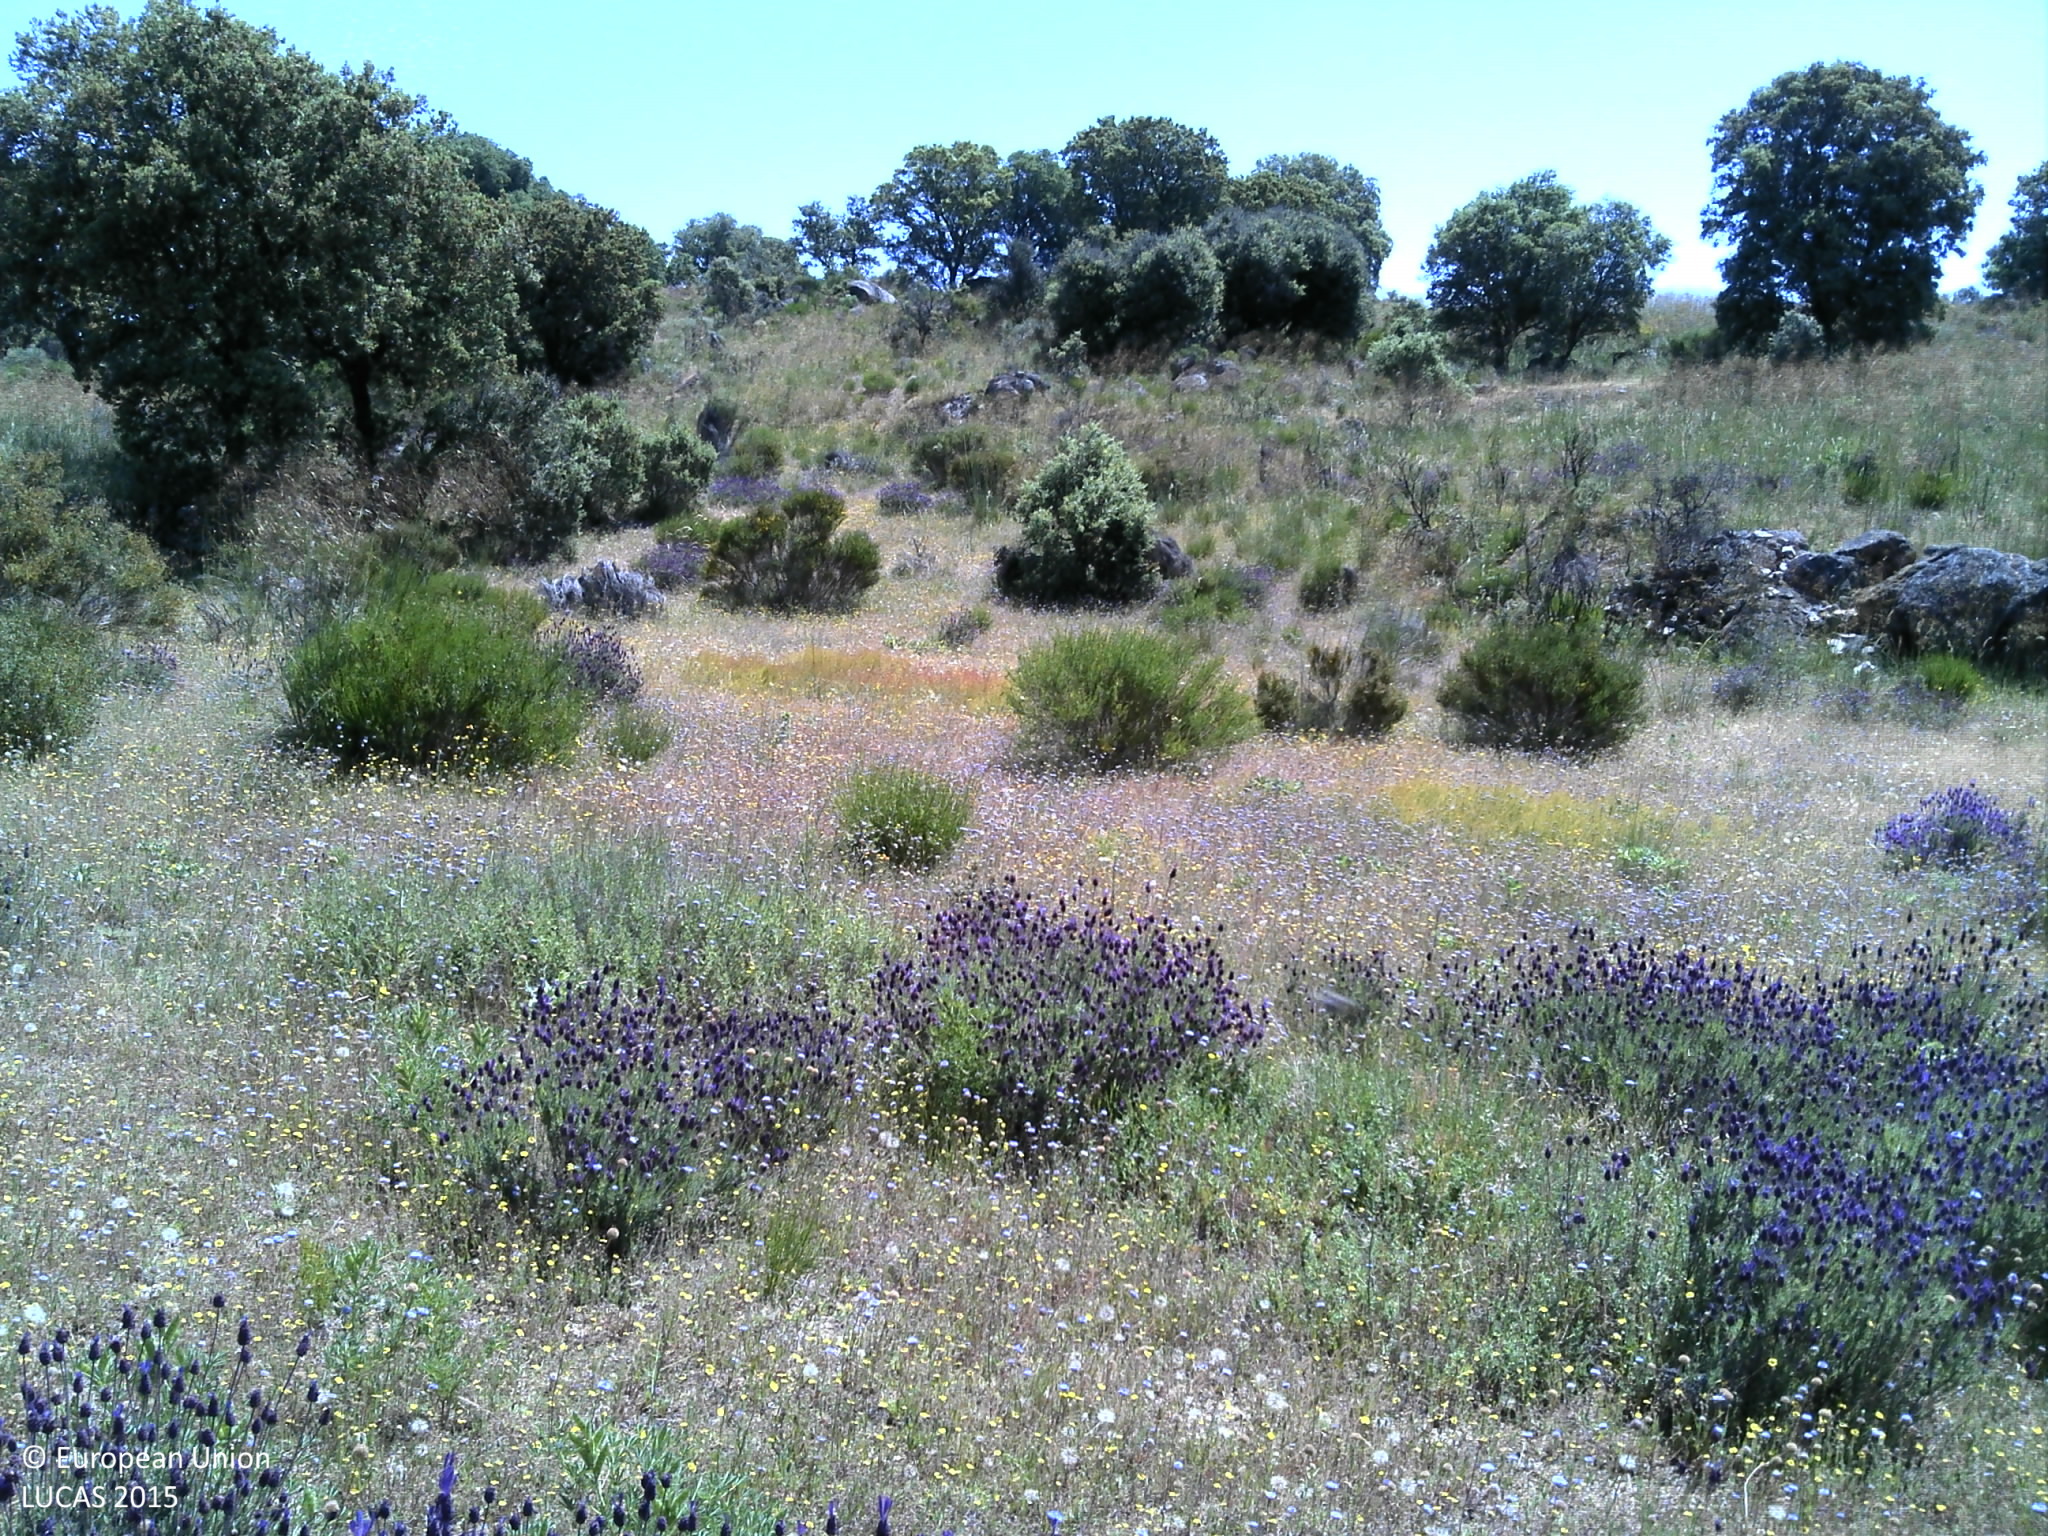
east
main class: Grassland
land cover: Grassland with sparse tree/shrub cover
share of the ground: > 75 %
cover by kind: herbaceous plants 90 %, broadleaved forest trees 5 %, shrubs 5 %
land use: Agriculture (excluding fallow land and kitchen gardens)
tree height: > 5 m
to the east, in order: Grassland with sparse tree/shrub cover; Rock outcrops; Grassland with sparse tree/shrub cover; Spontaneously vegetated surfaces; Shrubland with sparse tree cover; Fences; Shrubland with sparse tree cover
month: May
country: PT
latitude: 41.5448
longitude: -6.2942
